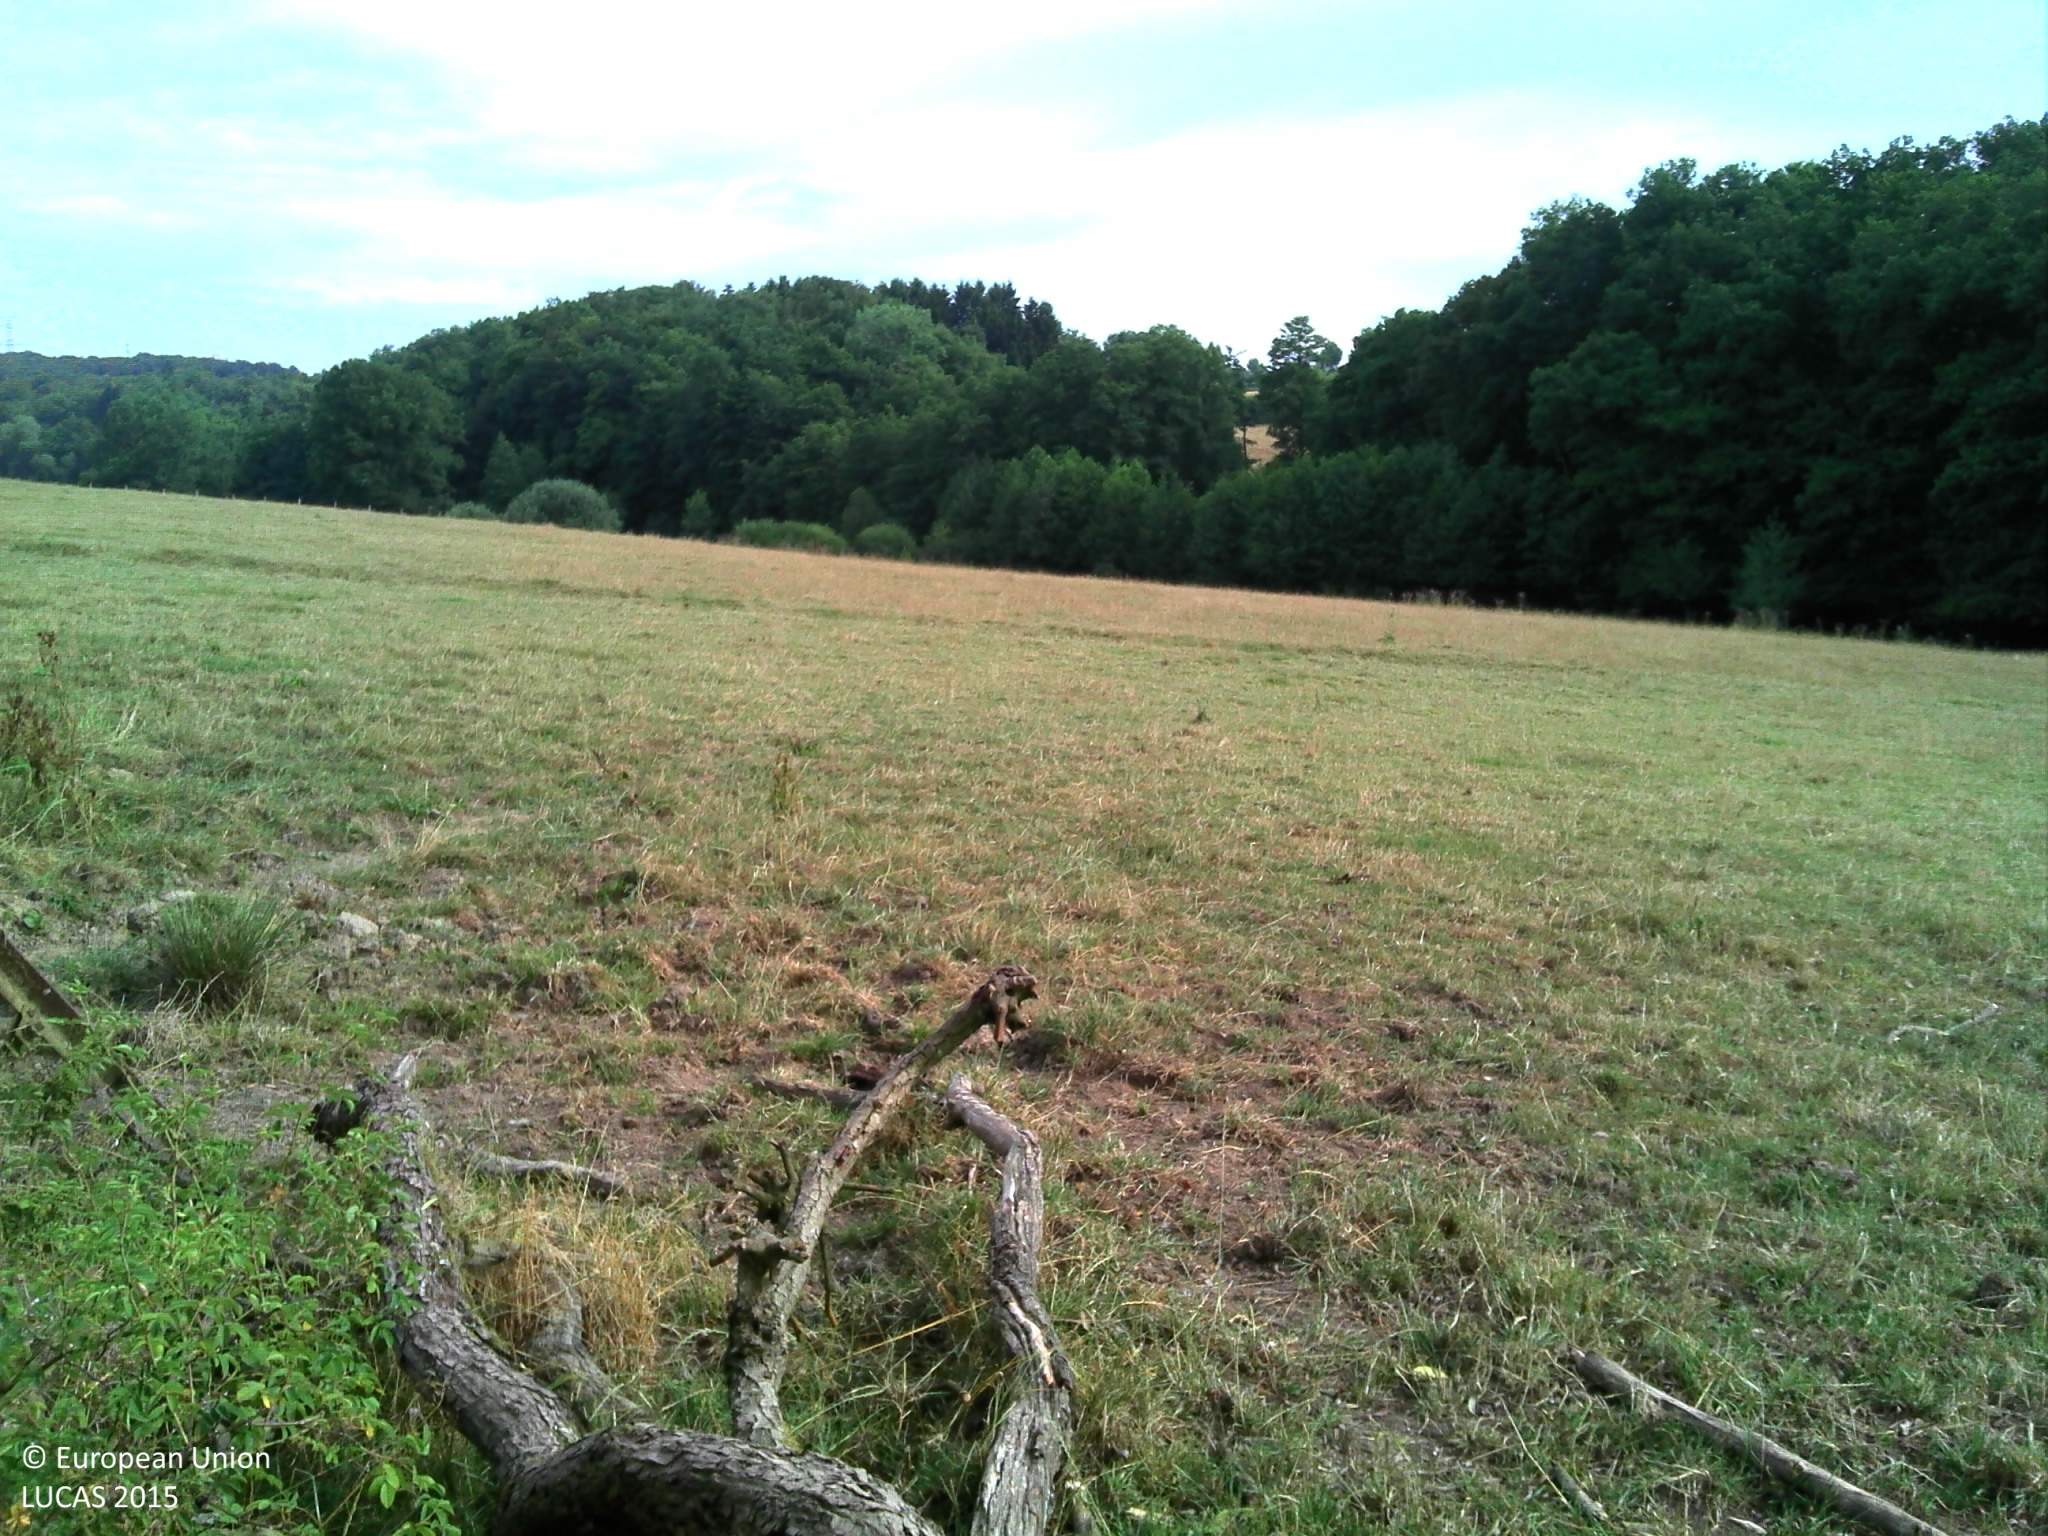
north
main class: Grassland
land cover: Grassland with sparse tree/shrub cover
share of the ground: > 75 %
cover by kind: herbaceous plants 95 %, broadleaved forest trees 5 %
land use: Agriculture (excluding fallow land and kitchen gardens)
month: July
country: BE
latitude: 49.7634
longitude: 5.7646
